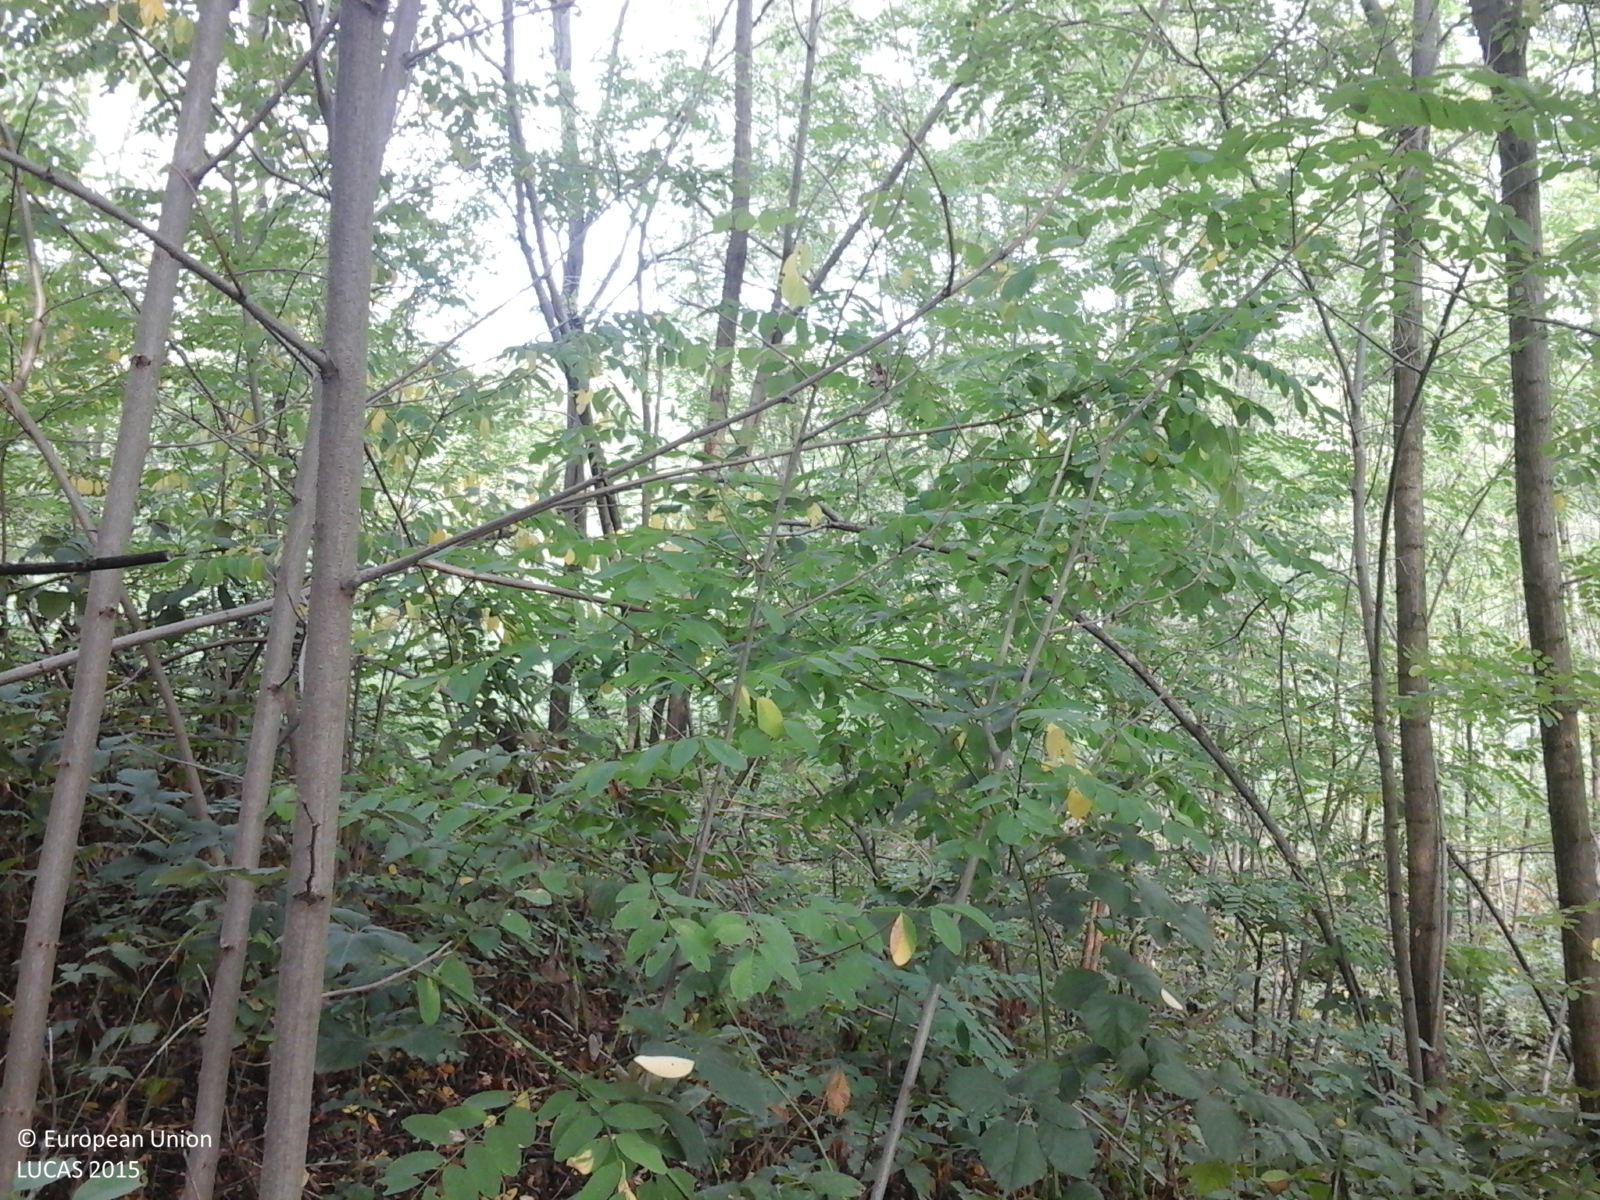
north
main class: Woodland
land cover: Broadleaved woodland
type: exotic forest
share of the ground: > 75 %
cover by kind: broadleaved forest trees 100 %
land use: Forestry
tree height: > 5 m
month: September
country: RO
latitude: 45.4997
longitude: 22.0821
